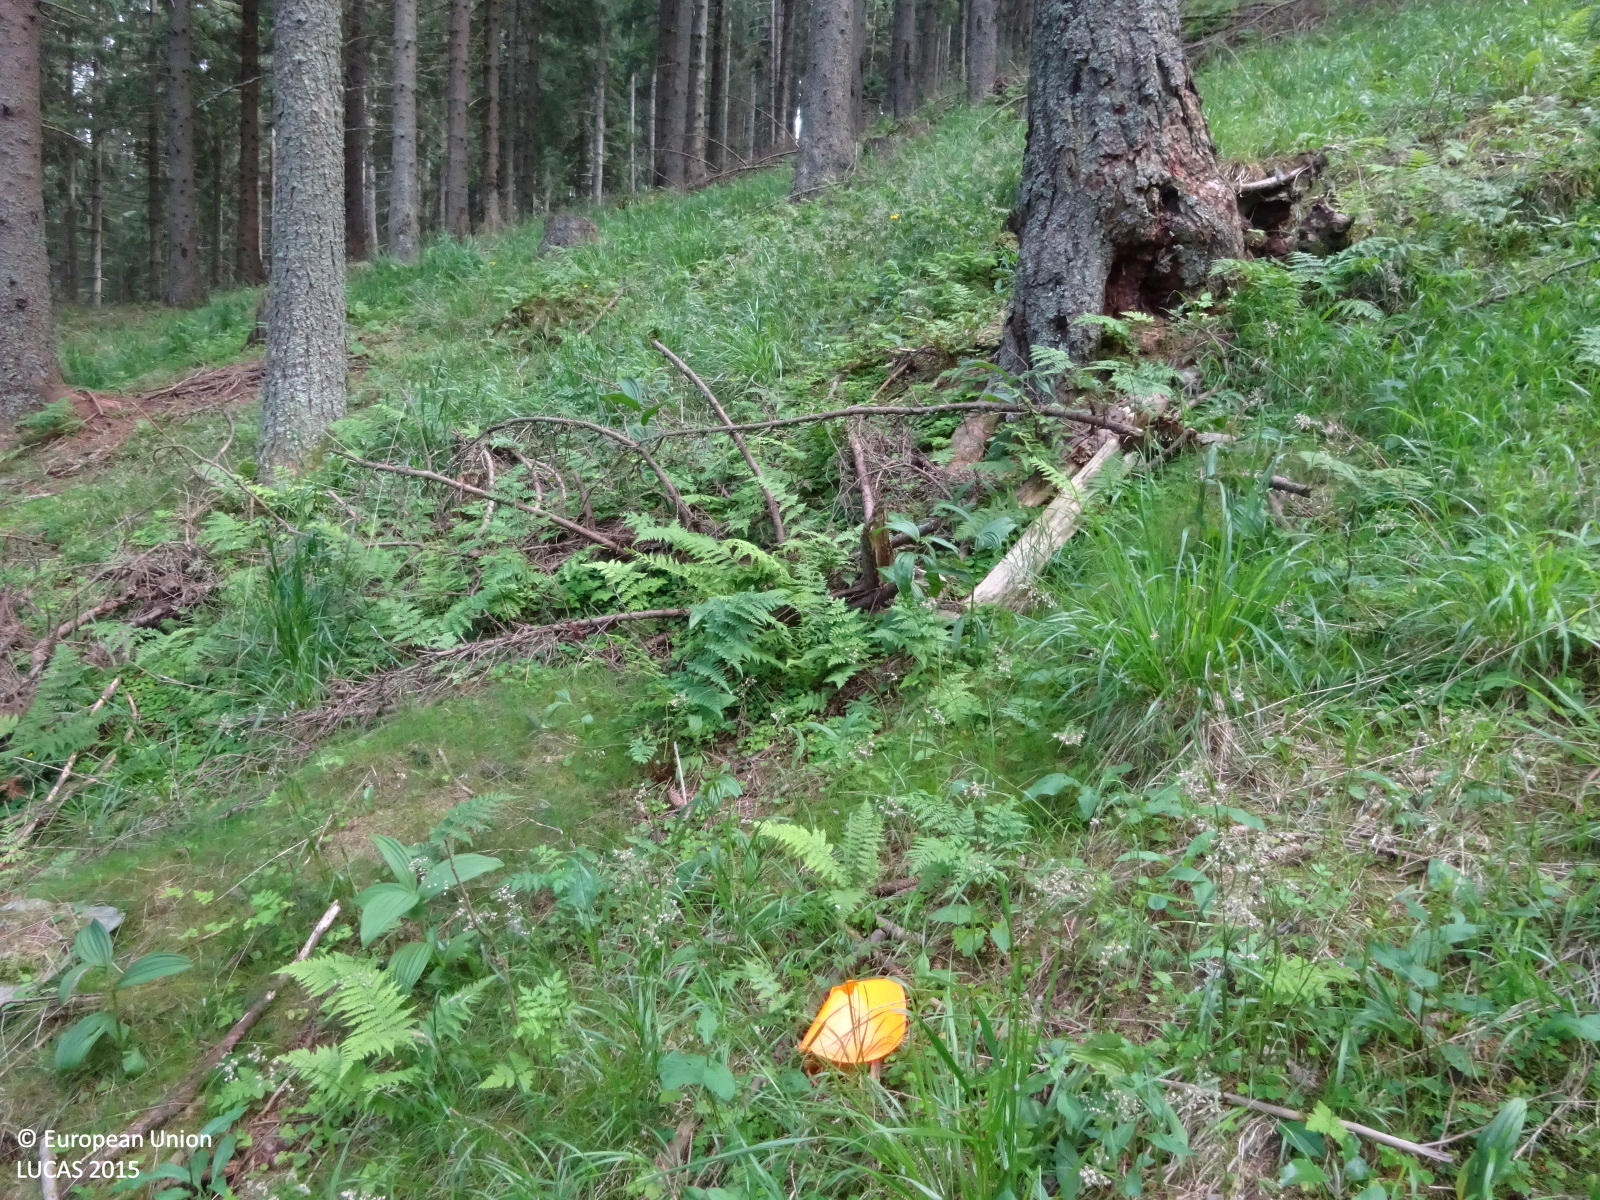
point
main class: Woodland
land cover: Spruce dominated coniferous woodland
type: alpine coniferous forest
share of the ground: > 75 %
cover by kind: coniferous forest trees 90 %, herbaceous plants 10 %
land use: Forestry
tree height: > 5 m
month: June
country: AT
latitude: 47.6010
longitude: 15.8143
